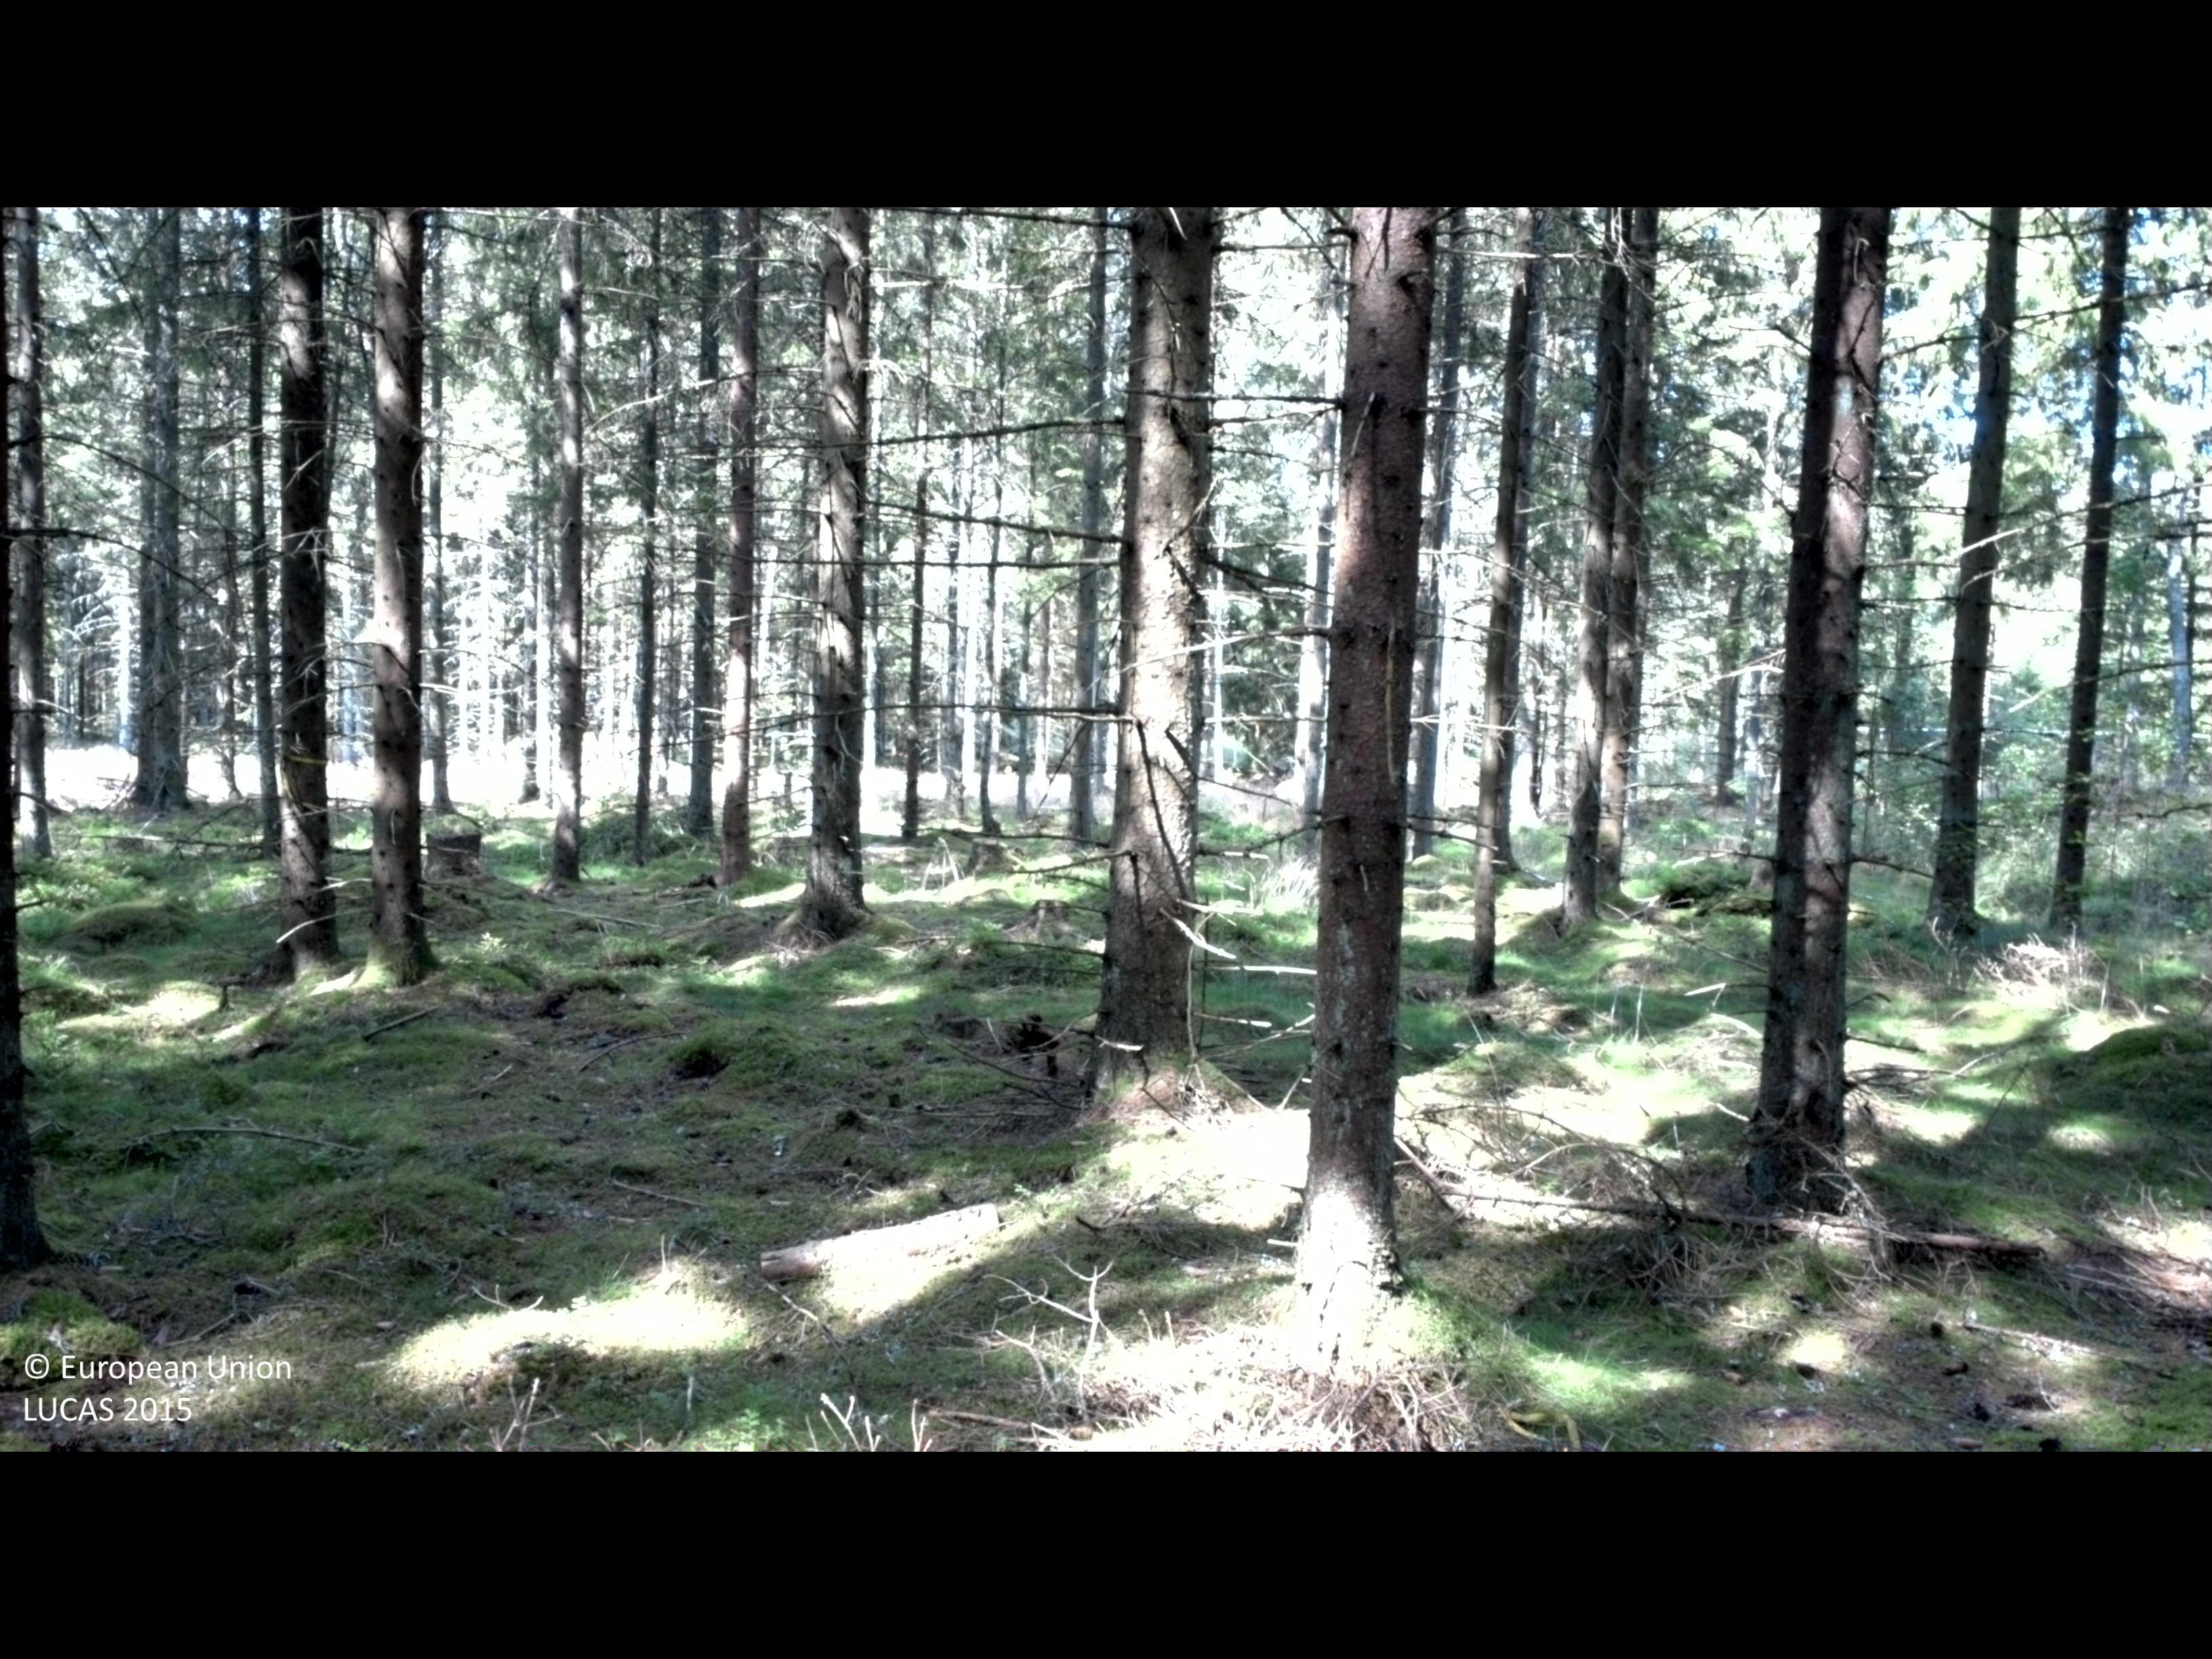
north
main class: Woodland
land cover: Spruce dominated coniferous woodland
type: boreal forest
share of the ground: > 75 %
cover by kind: coniferous forest trees 80 %, lichens and mosses 15 %, shrubs 5 %
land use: Forestry
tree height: > 5 m
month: August
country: SE
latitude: 56.8580
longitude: 14.1787
